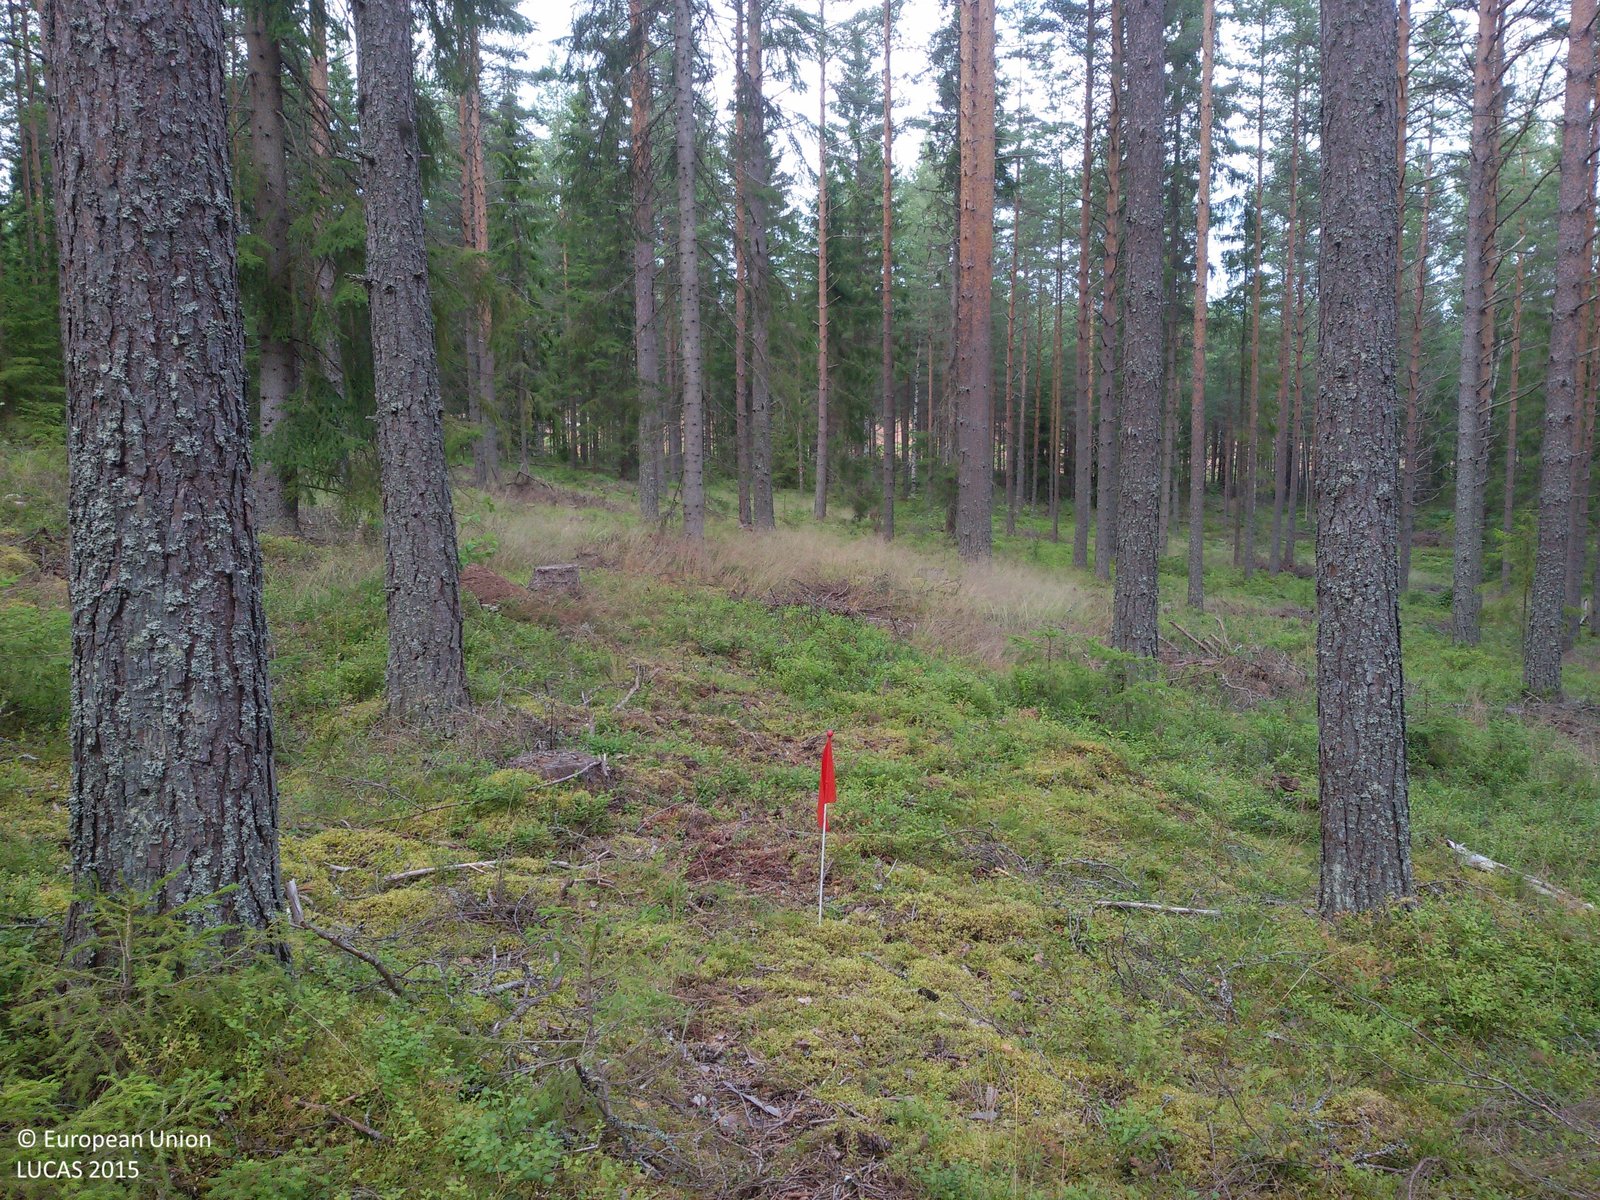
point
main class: Woodland
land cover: Pine dominated coniferous woodland
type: boreal forest
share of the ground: 50 - 75 %
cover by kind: coniferous forest trees 70 %, shrubs 15 %, lichens and mosses 15 %
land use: Forestry
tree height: > 5 m
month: July
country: SE
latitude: 60.4592
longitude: 15.7882
